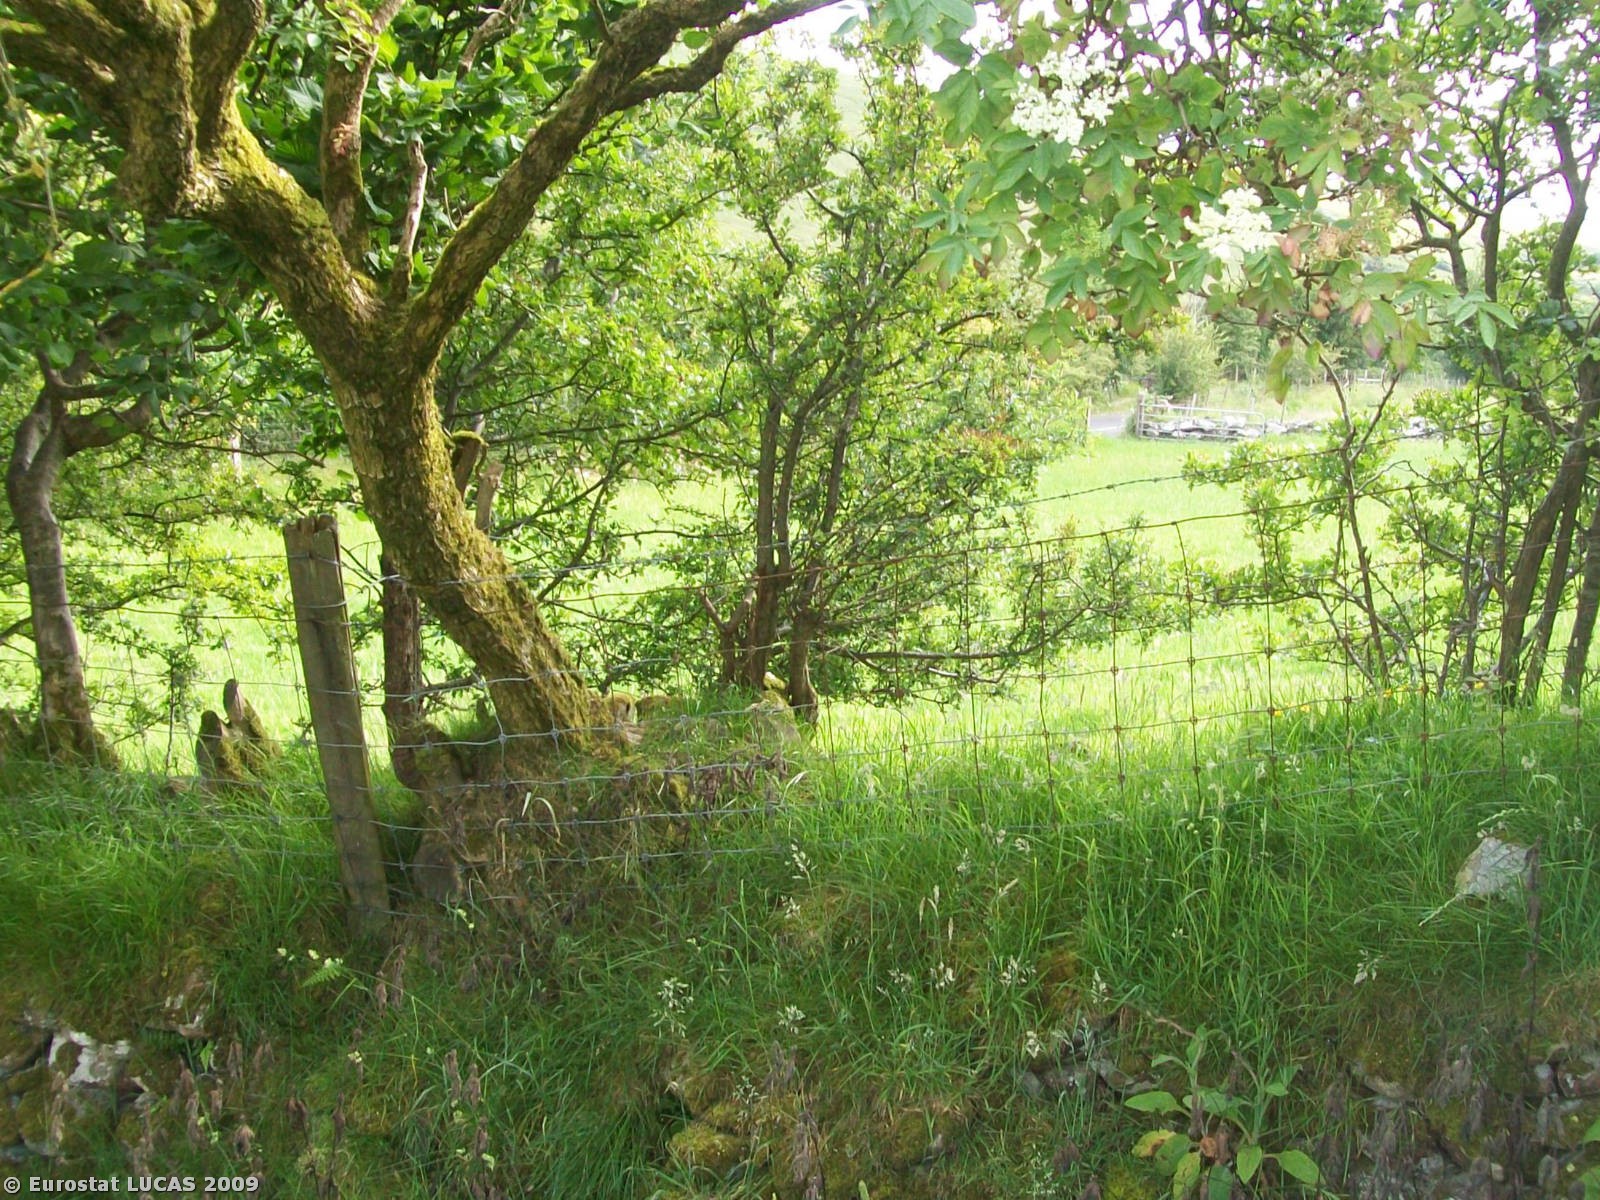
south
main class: Grassland
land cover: Grassland without tree/shrub cover
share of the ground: > 75 %
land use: Agriculture (excluding fallow land and kitchen gardens)
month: July
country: GB
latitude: 54.8724
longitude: -7.0158
